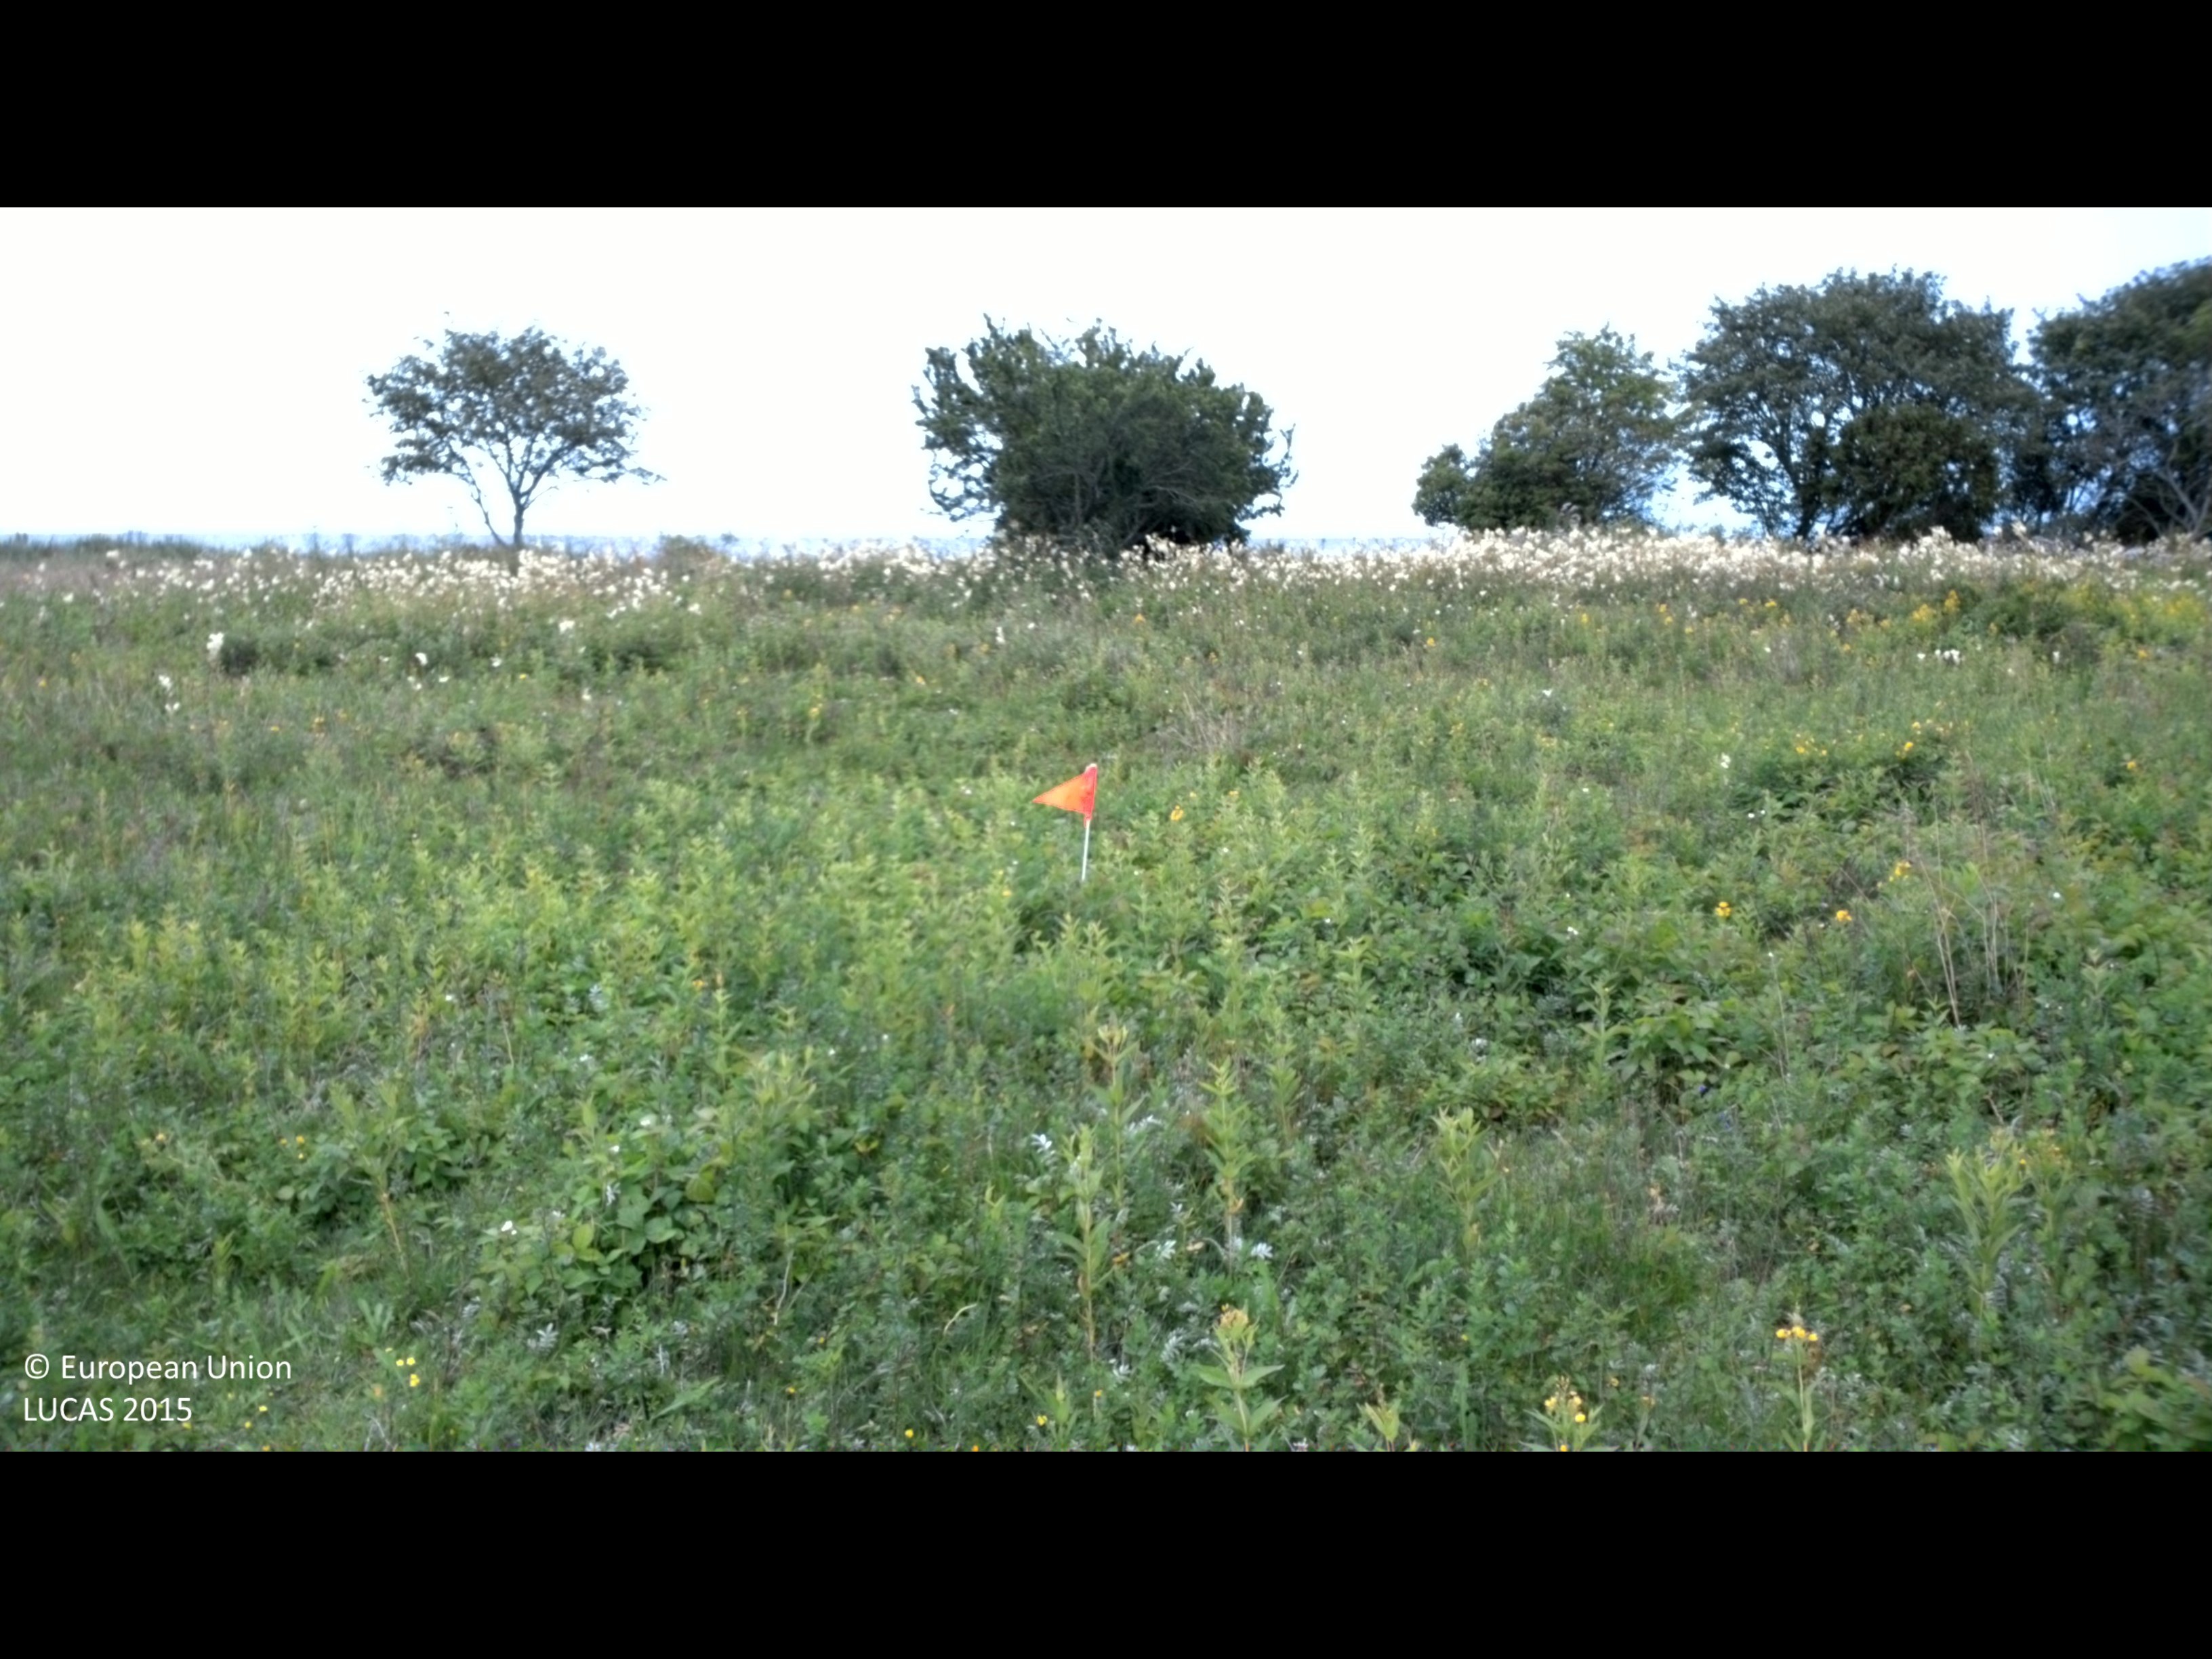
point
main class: Grassland
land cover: Grassland without tree/shrub cover
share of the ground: > 75 %
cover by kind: herbaceous plants 100 %
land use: Agriculture (excluding fallow land and kitchen gardens)
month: July
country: SE
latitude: 57.1328
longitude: 17.0238
